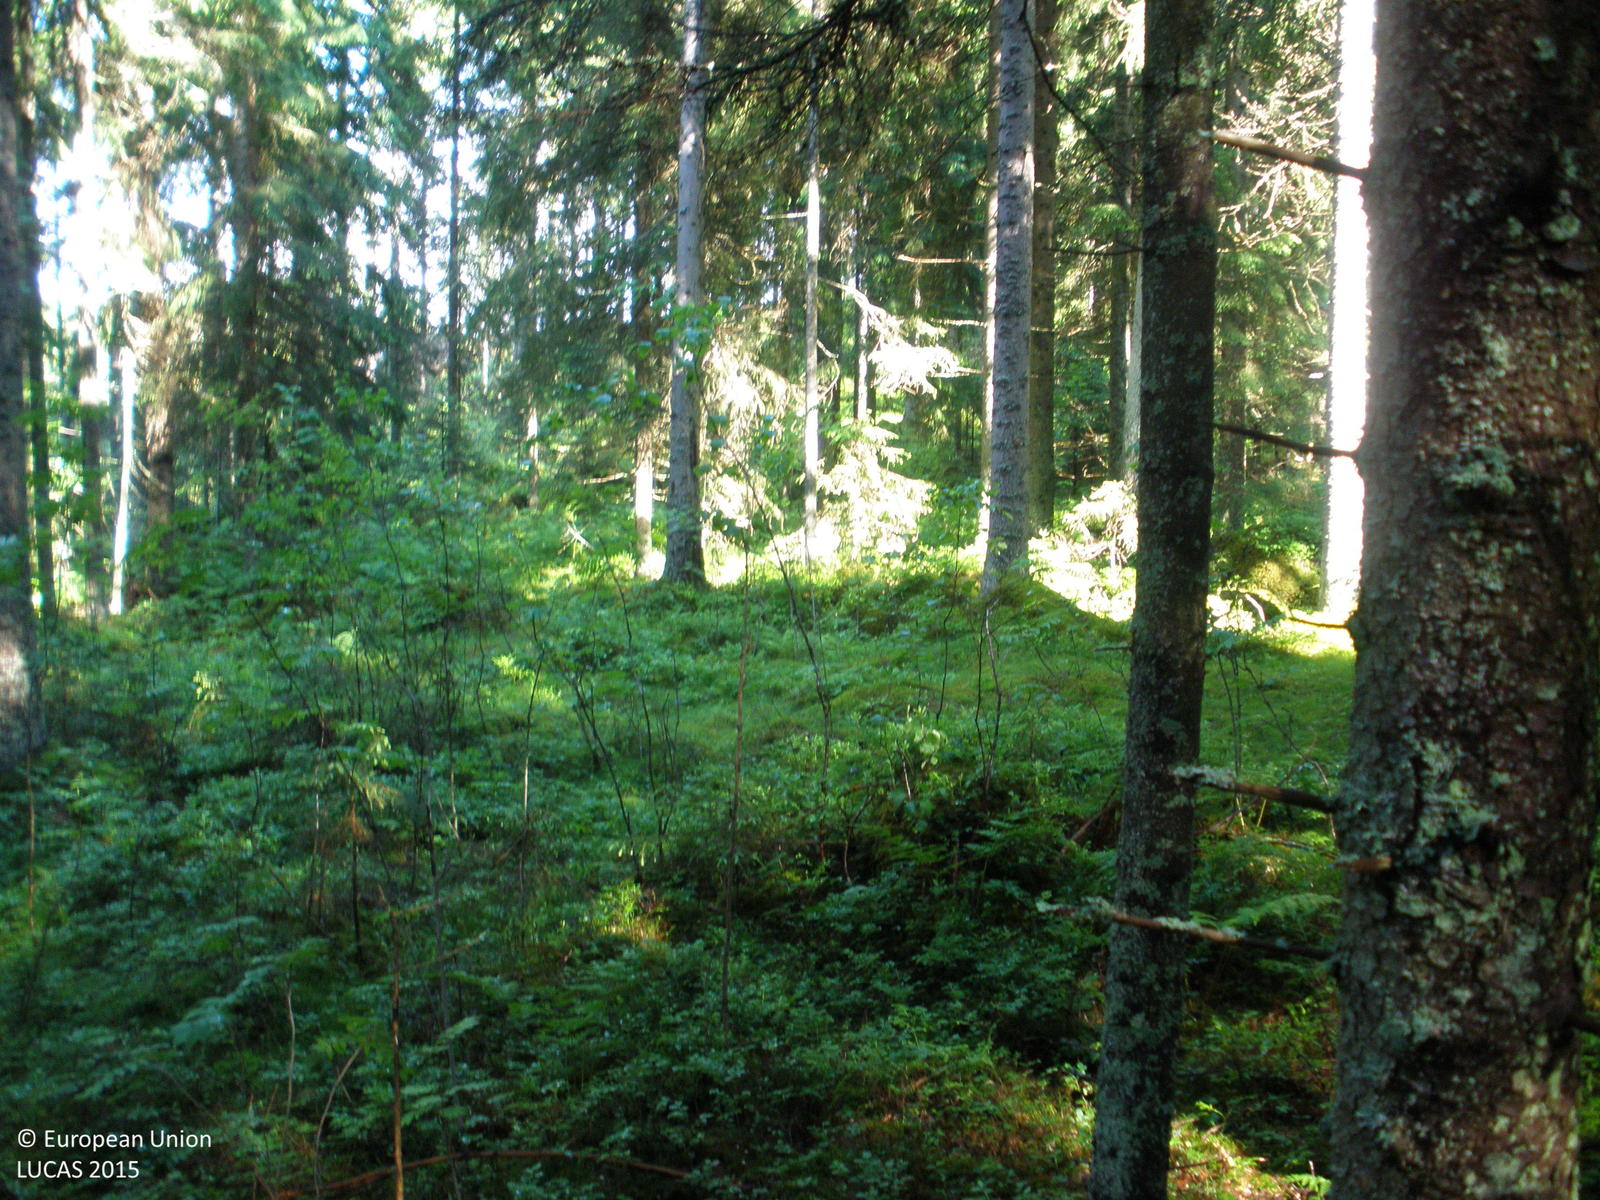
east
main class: Woodland
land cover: Spruce dominated coniferous woodland
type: boreal forest
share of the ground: > 75 %
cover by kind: coniferous forest trees 95 %, lichens and mosses 5 %
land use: Forestry
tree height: > 5 m
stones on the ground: < 10 %
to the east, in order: Spruce dominated coniferous woodland; Other bare soil; Broadleaved woodland; Spruce dominated mixed woodland; Broadleaved woodland; Grassland with sparse tree/shrub cover
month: June
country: FI
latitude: 60.9904
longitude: 23.5224
